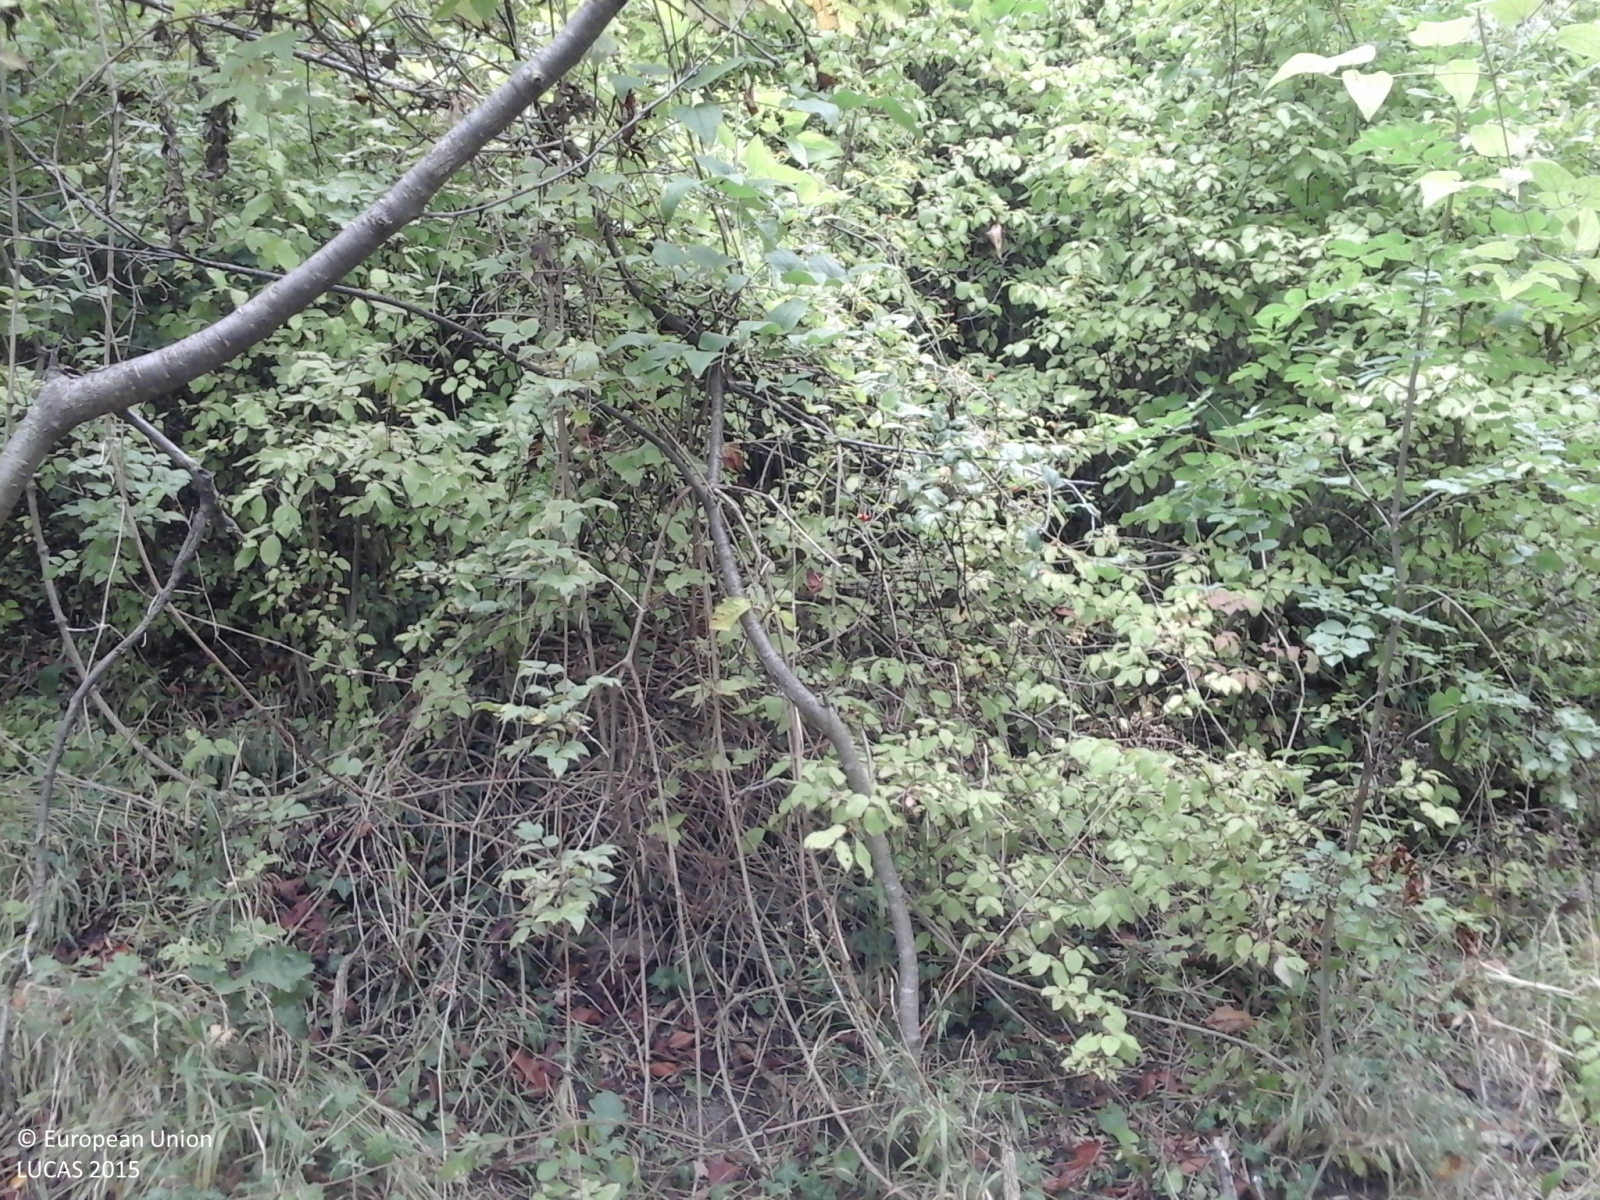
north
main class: Woodland
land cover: Broadleaved woodland
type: mesophytic deciduous forest
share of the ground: > 75 %
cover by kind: broadleaved forest trees 80 %, shrubs 15 %, herbaceous plants 5 %
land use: Forestry
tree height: > 5 m
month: August
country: IT
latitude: 44.9785
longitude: 9.1773
